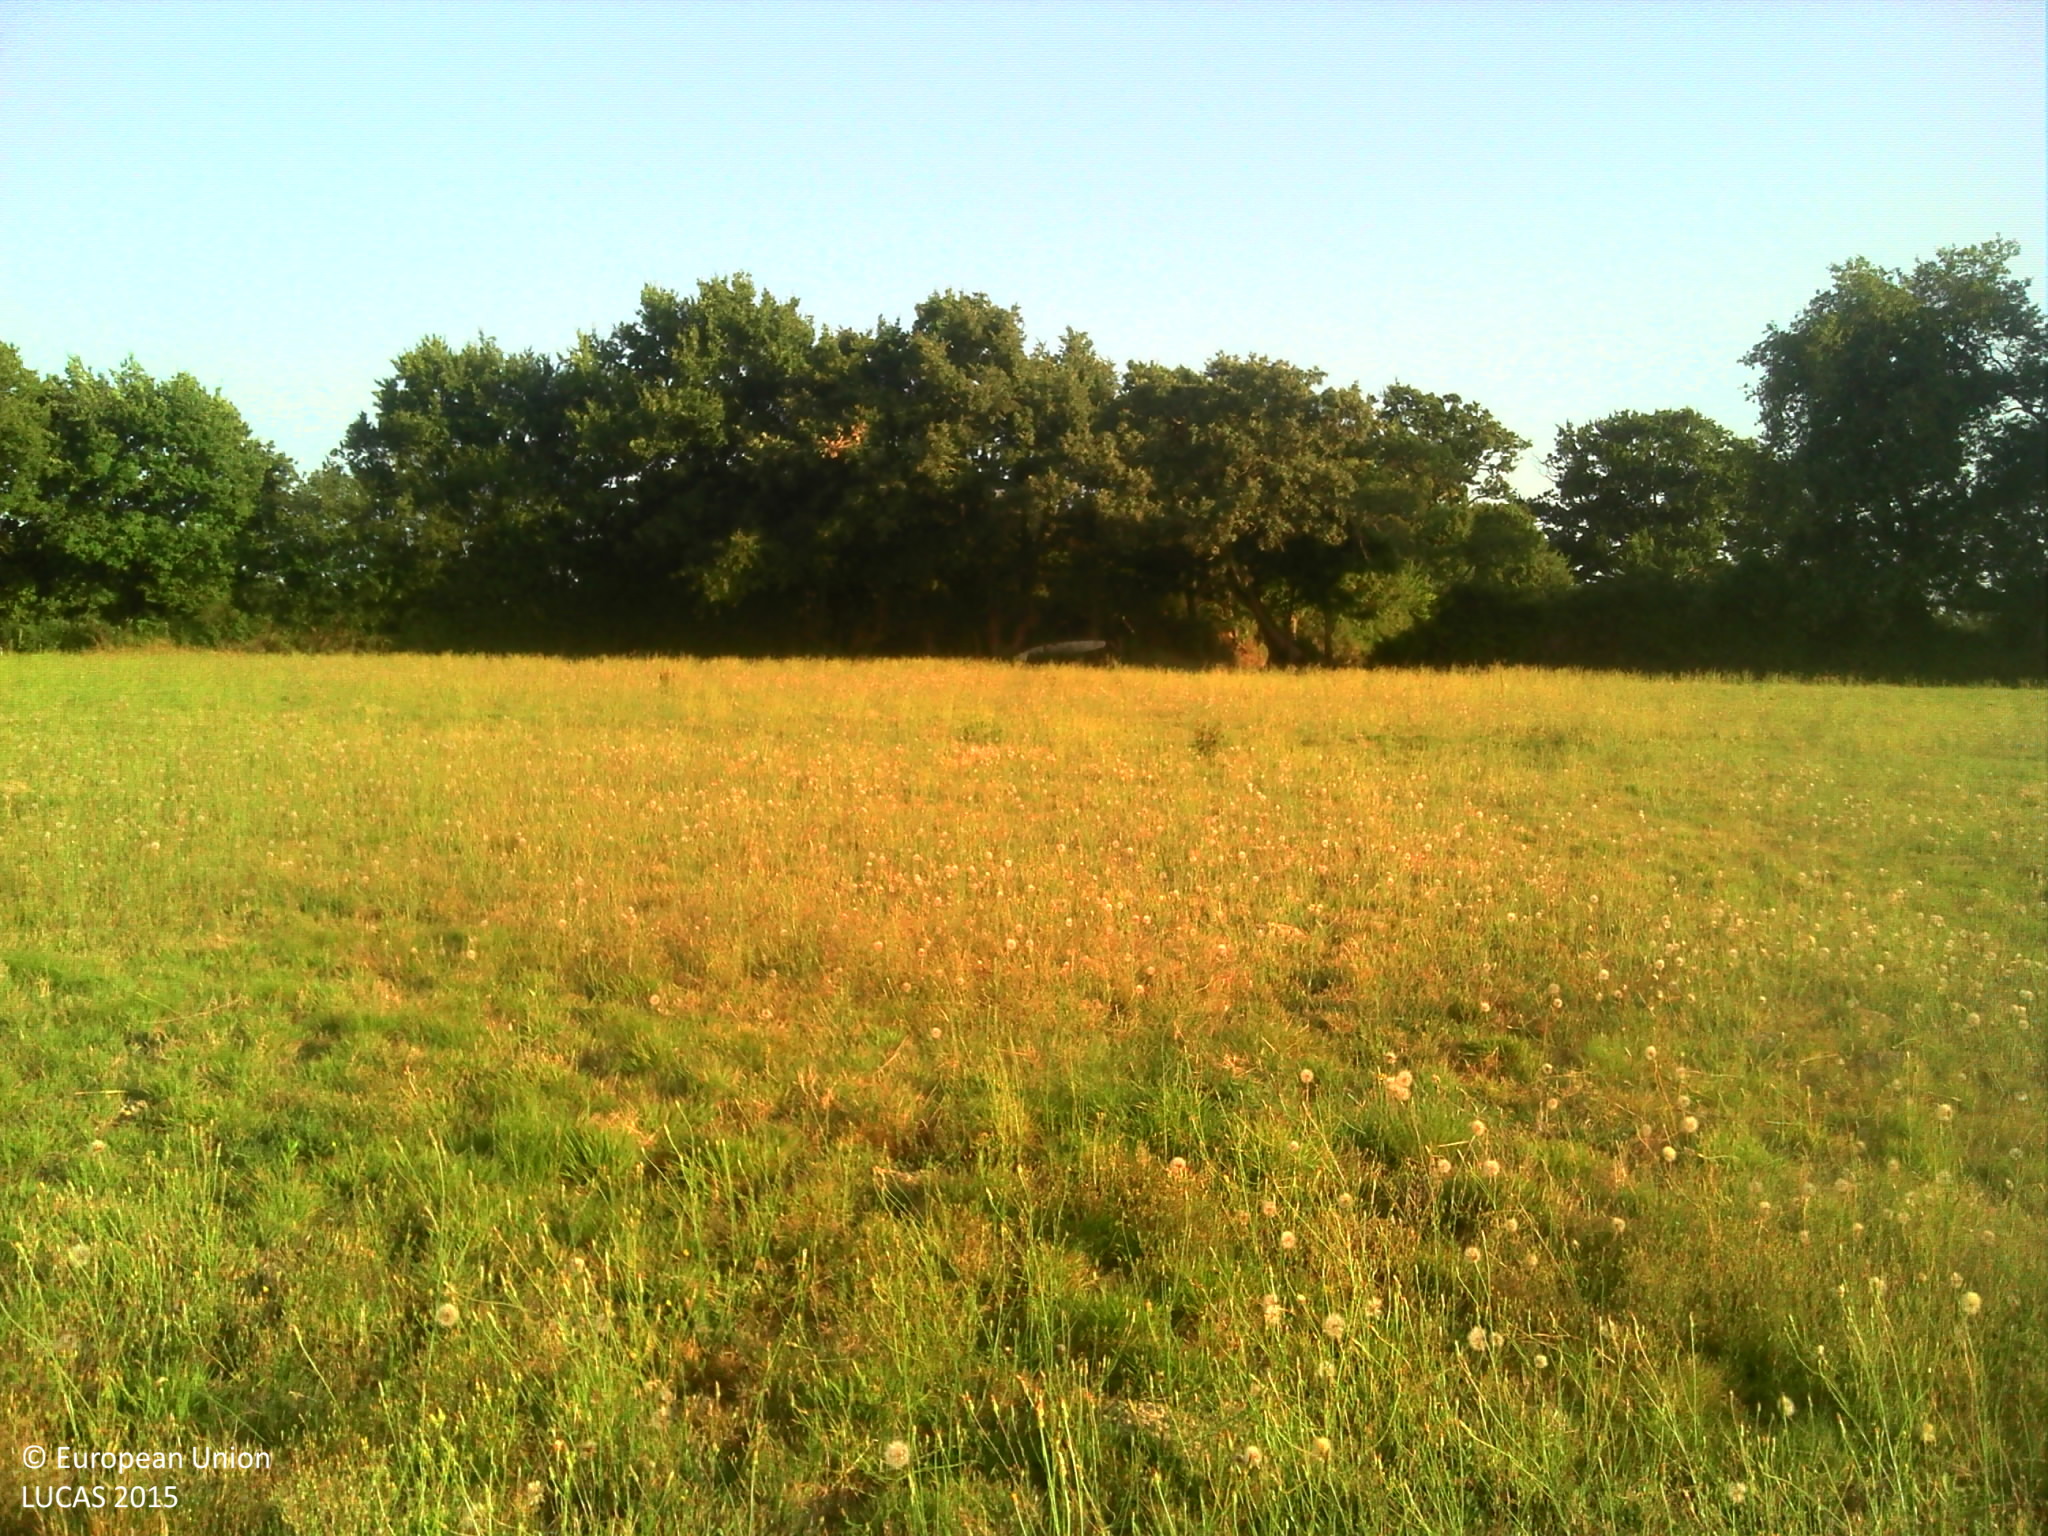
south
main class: Grassland
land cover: Grassland without tree/shrub cover
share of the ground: > 75 %
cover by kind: herbaceous plants 100 %
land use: Agriculture (excluding fallow land and kitchen gardens)
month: July
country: FR
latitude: 46.4917
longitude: -1.6742
